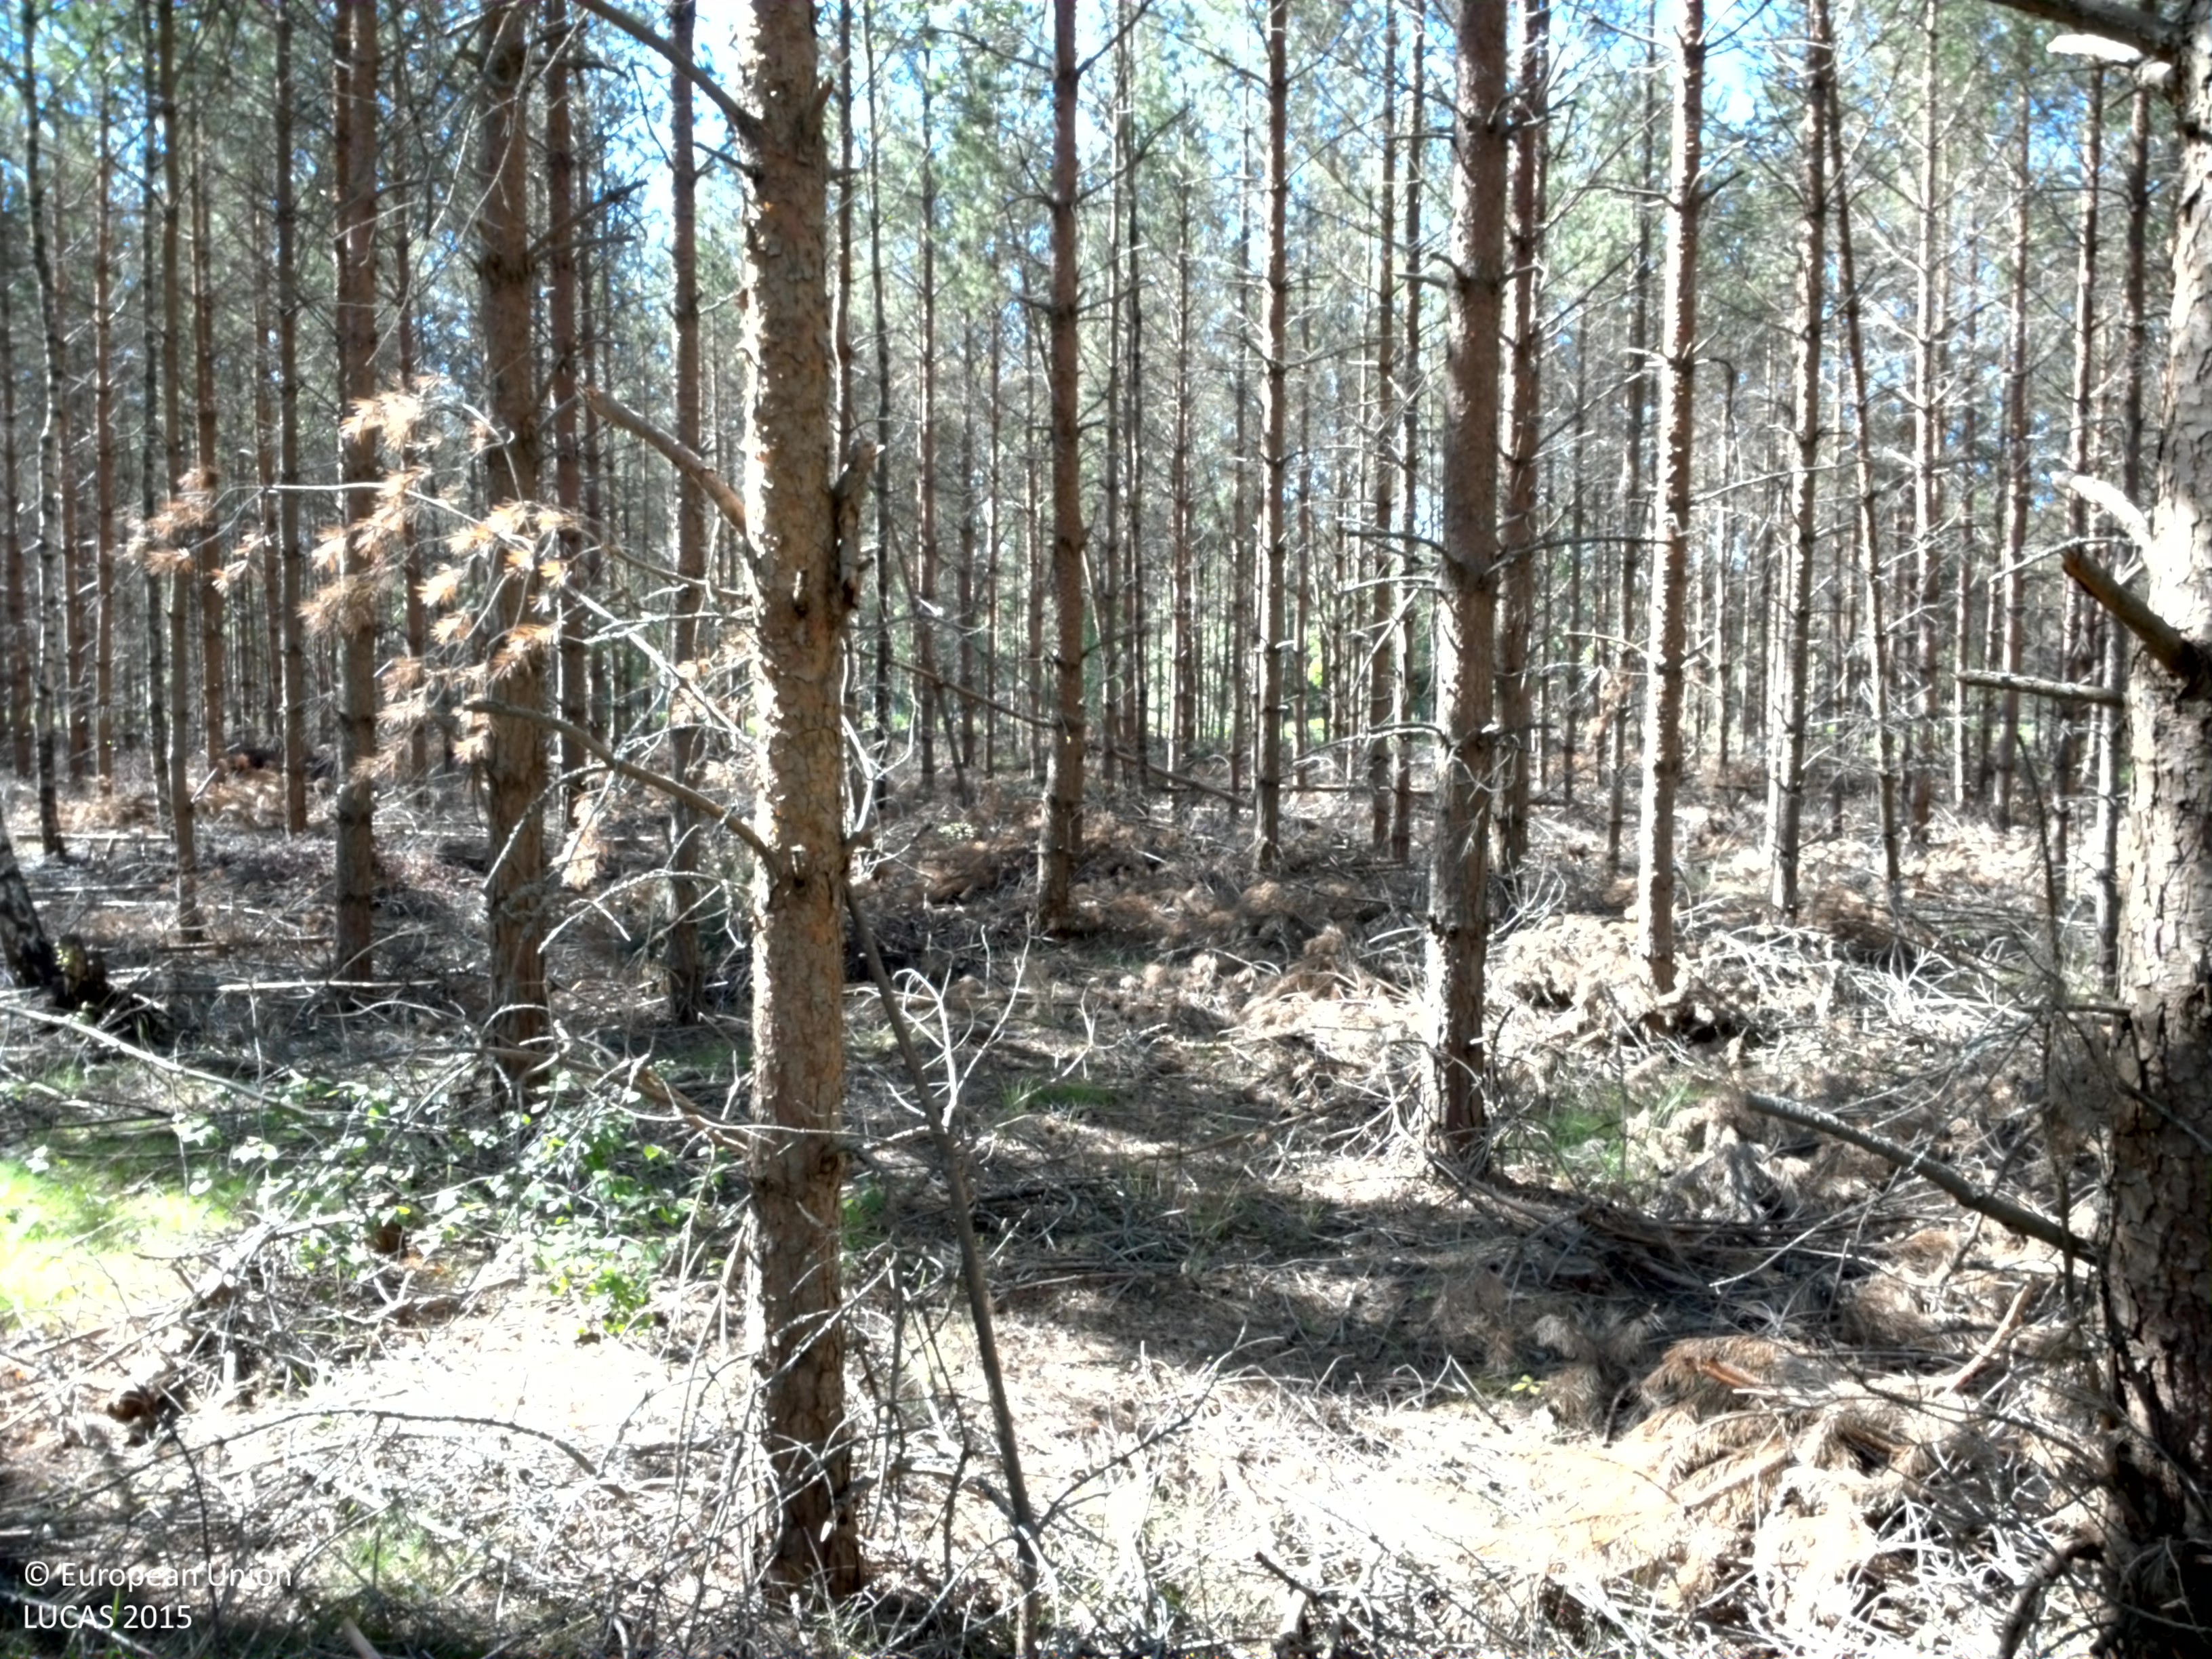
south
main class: Woodland
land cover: Pine dominated coniferous woodland
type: boreal forest
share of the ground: 25 - 50 %
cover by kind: coniferous forest trees 50 %, herbaceous plants 20 %, unconsolidated bare surface 10 %
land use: Community services
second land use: Forestry
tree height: > 5 m
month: June
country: SE
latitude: 58.5044
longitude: 14.5069
